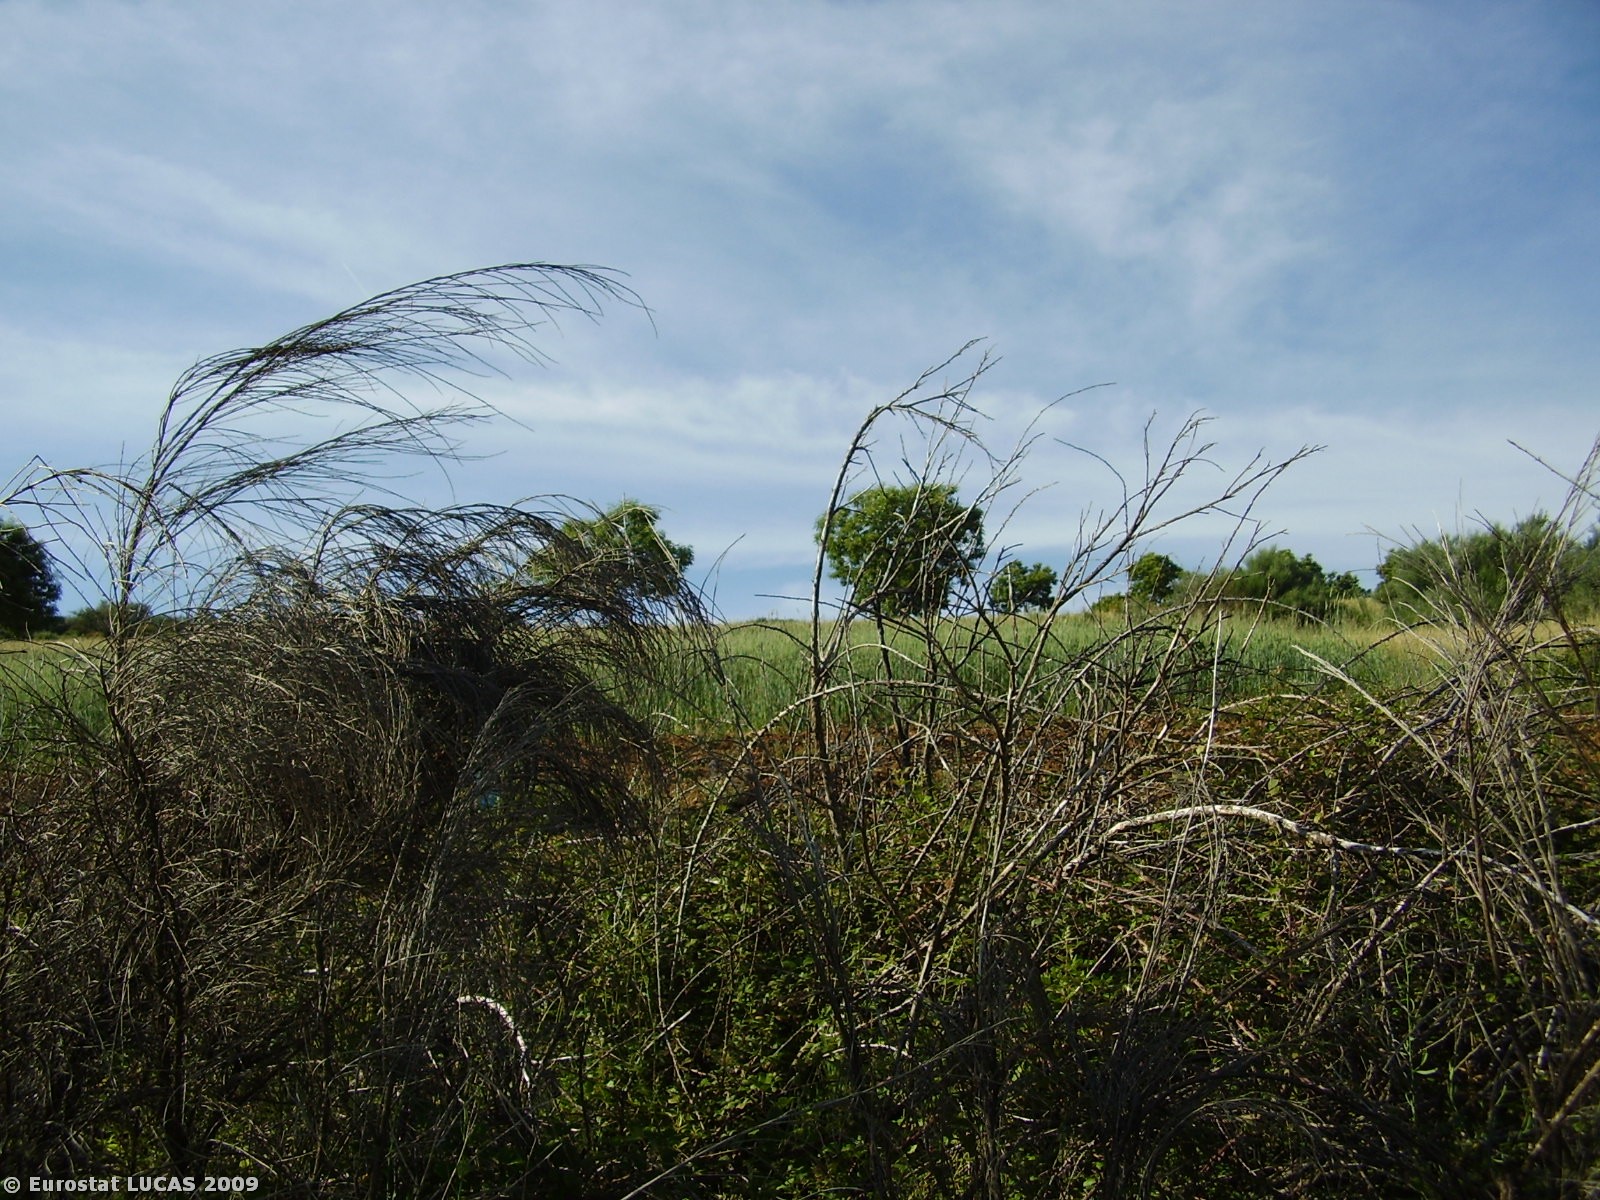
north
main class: Shrubland
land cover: Shrubland without tree cover
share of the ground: > 75 %
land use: Nature reserves
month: June
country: PT
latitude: 41.8757
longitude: -6.9519
